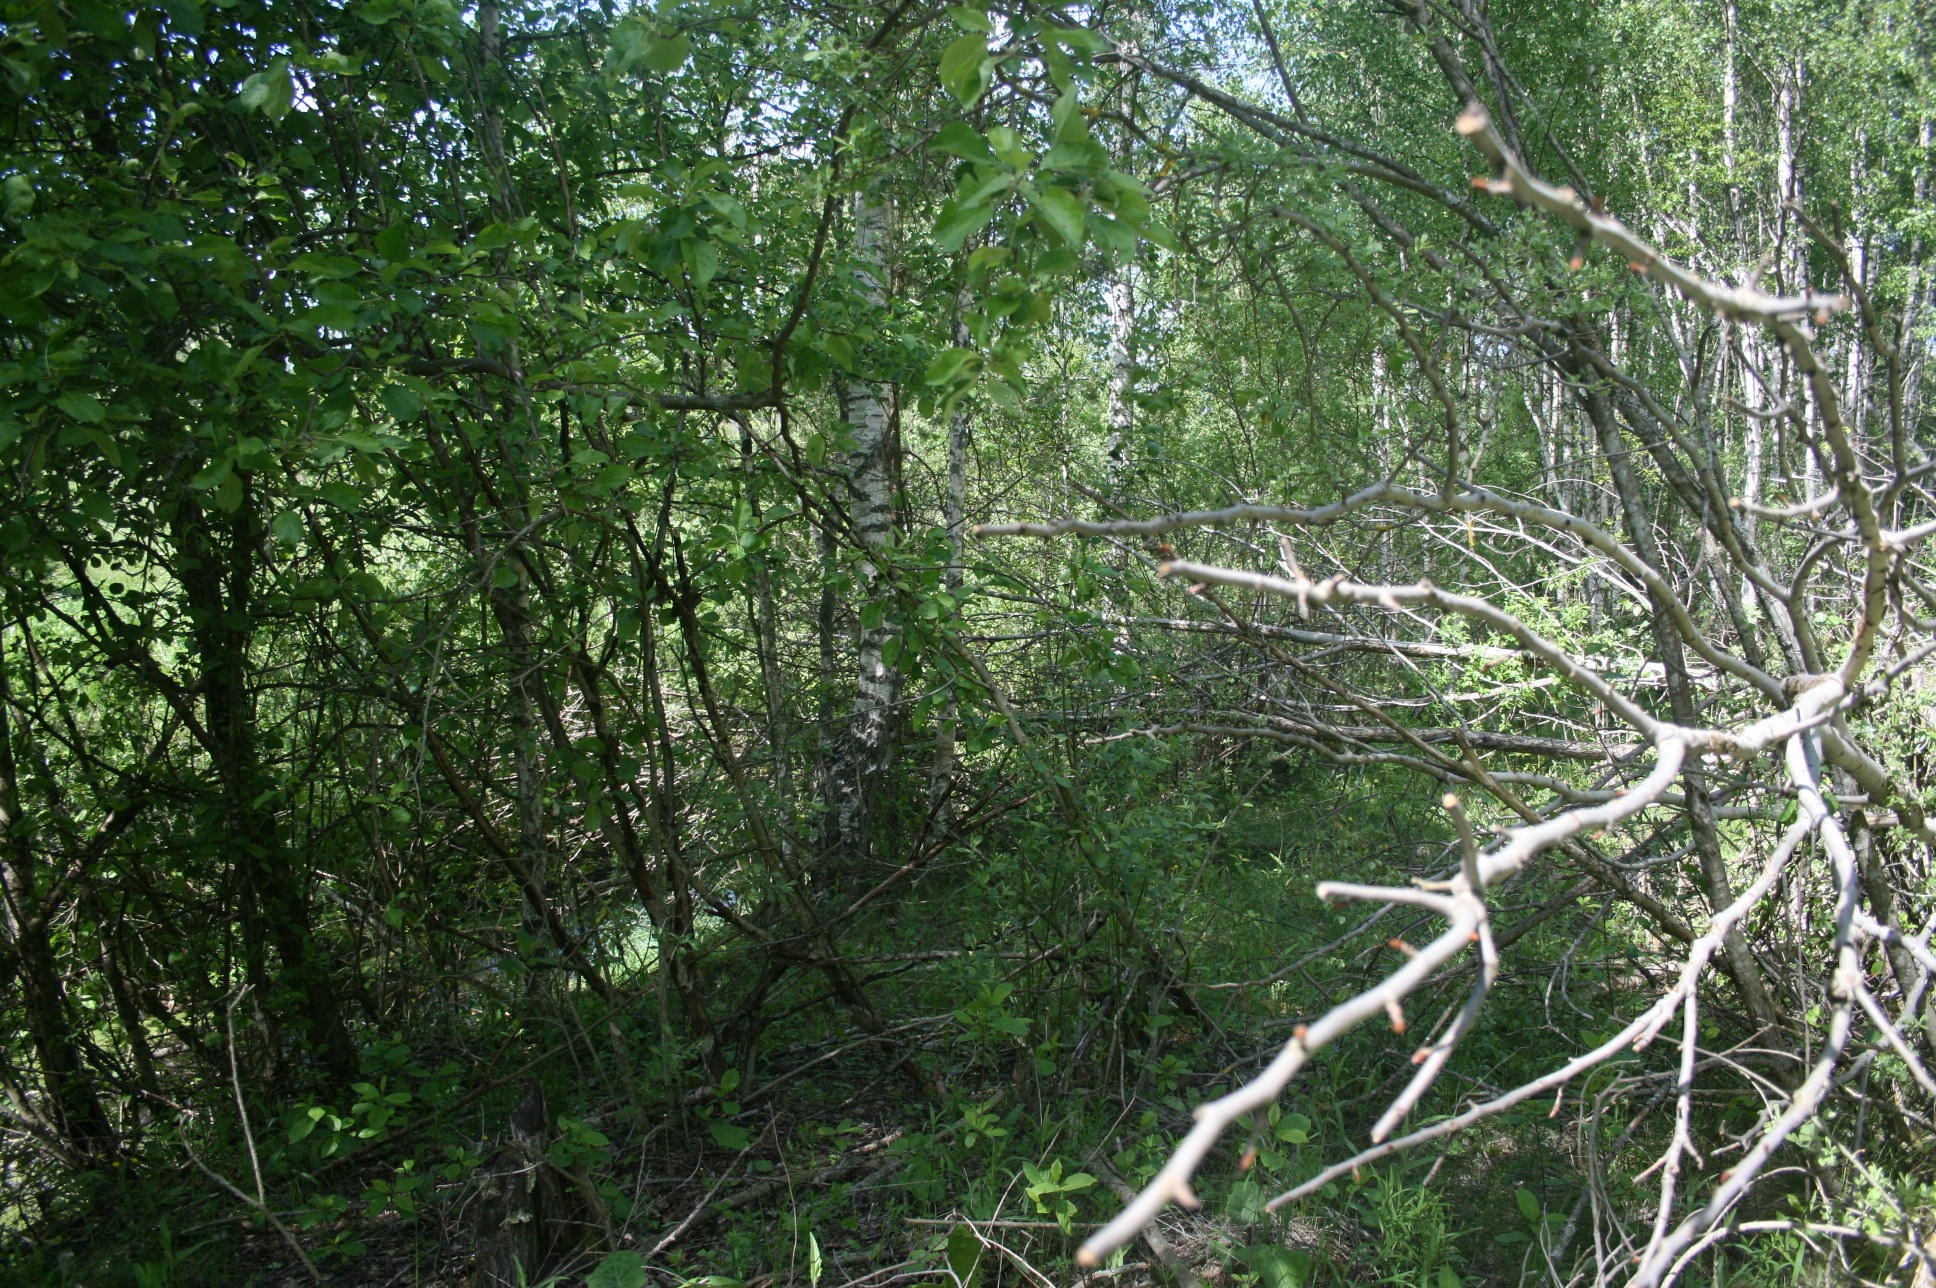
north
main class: Woodland
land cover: Broadleaved woodland
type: non-riverine alder, birch or aspen forest
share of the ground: > 75 %
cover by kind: broadleaved forest trees 85 %, herbaceous plants 10 %, coniferous forest trees 5 %
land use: Forestry
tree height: > 5 m
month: June
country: LT
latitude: 56.0802
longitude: 22.3485
